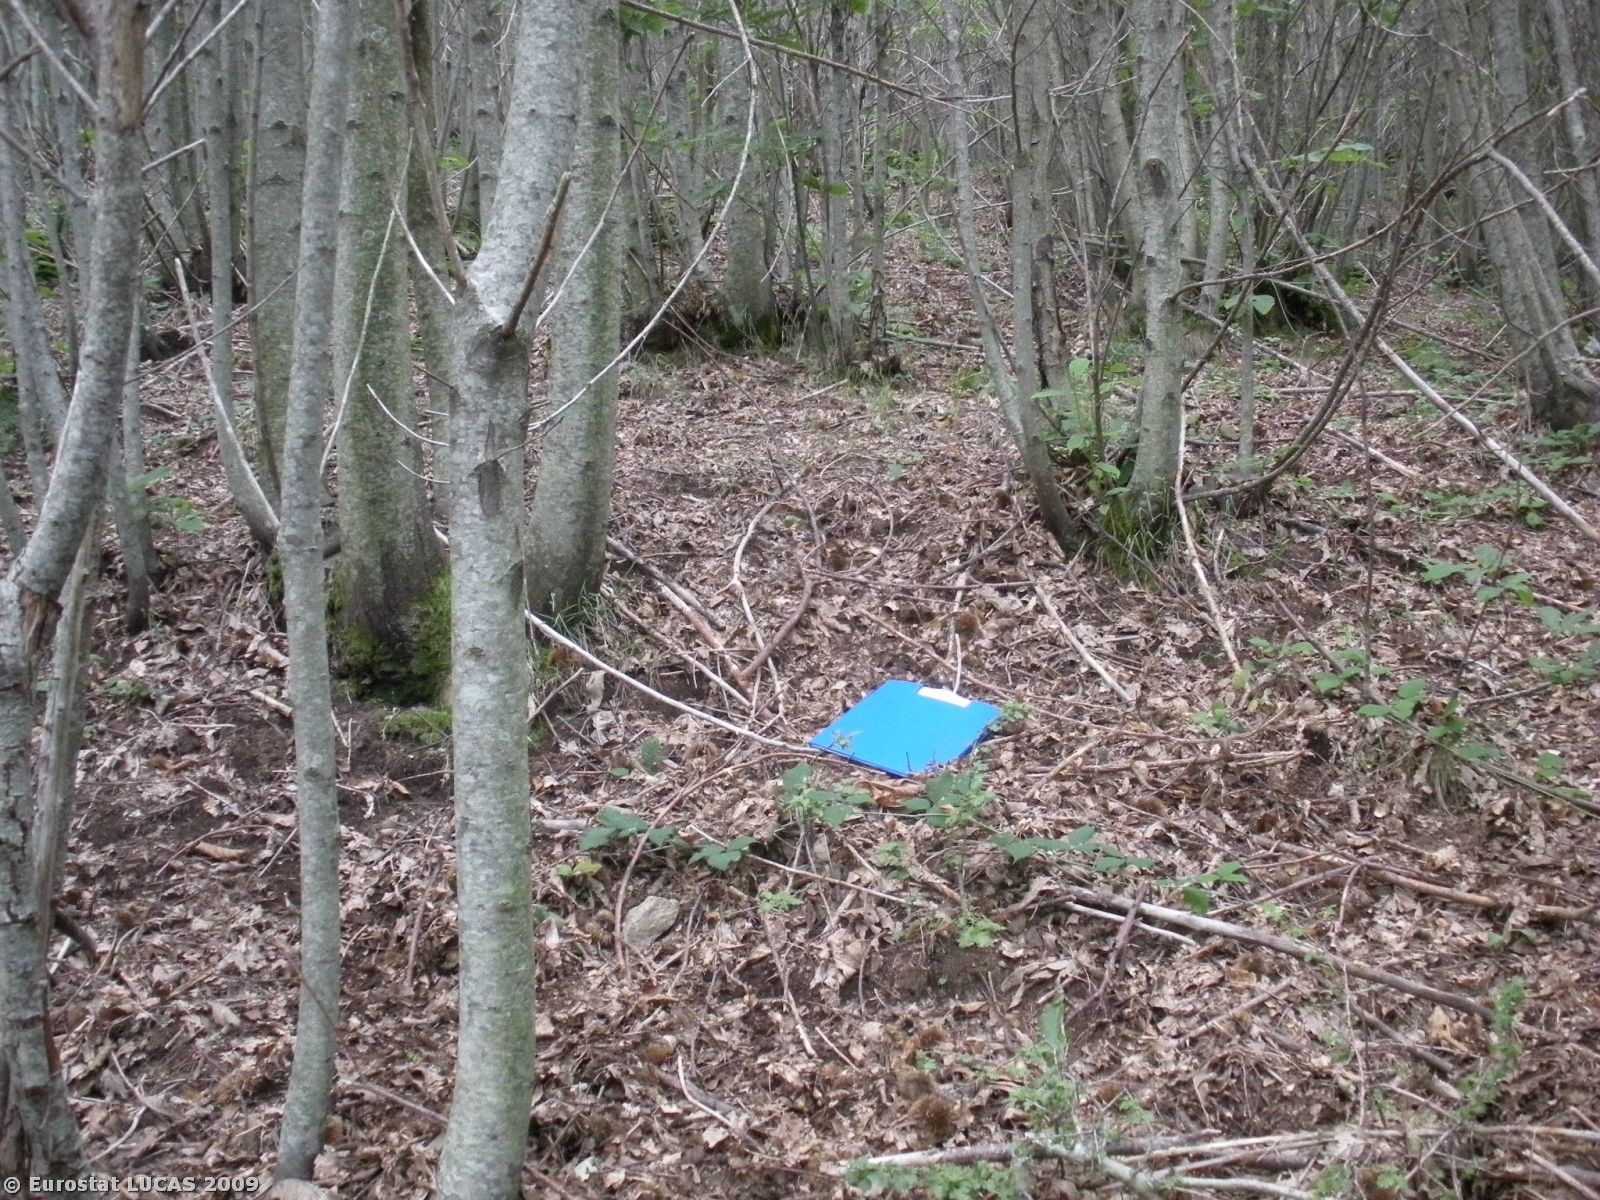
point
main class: Woodland
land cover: Broadleaved woodland
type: mesophytic deciduous forest
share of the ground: > 75 %
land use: Agriculture (excluding fallow land and kitchen gardens)
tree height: > 5 m
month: July
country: IT
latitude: 40.2451
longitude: 15.0675
